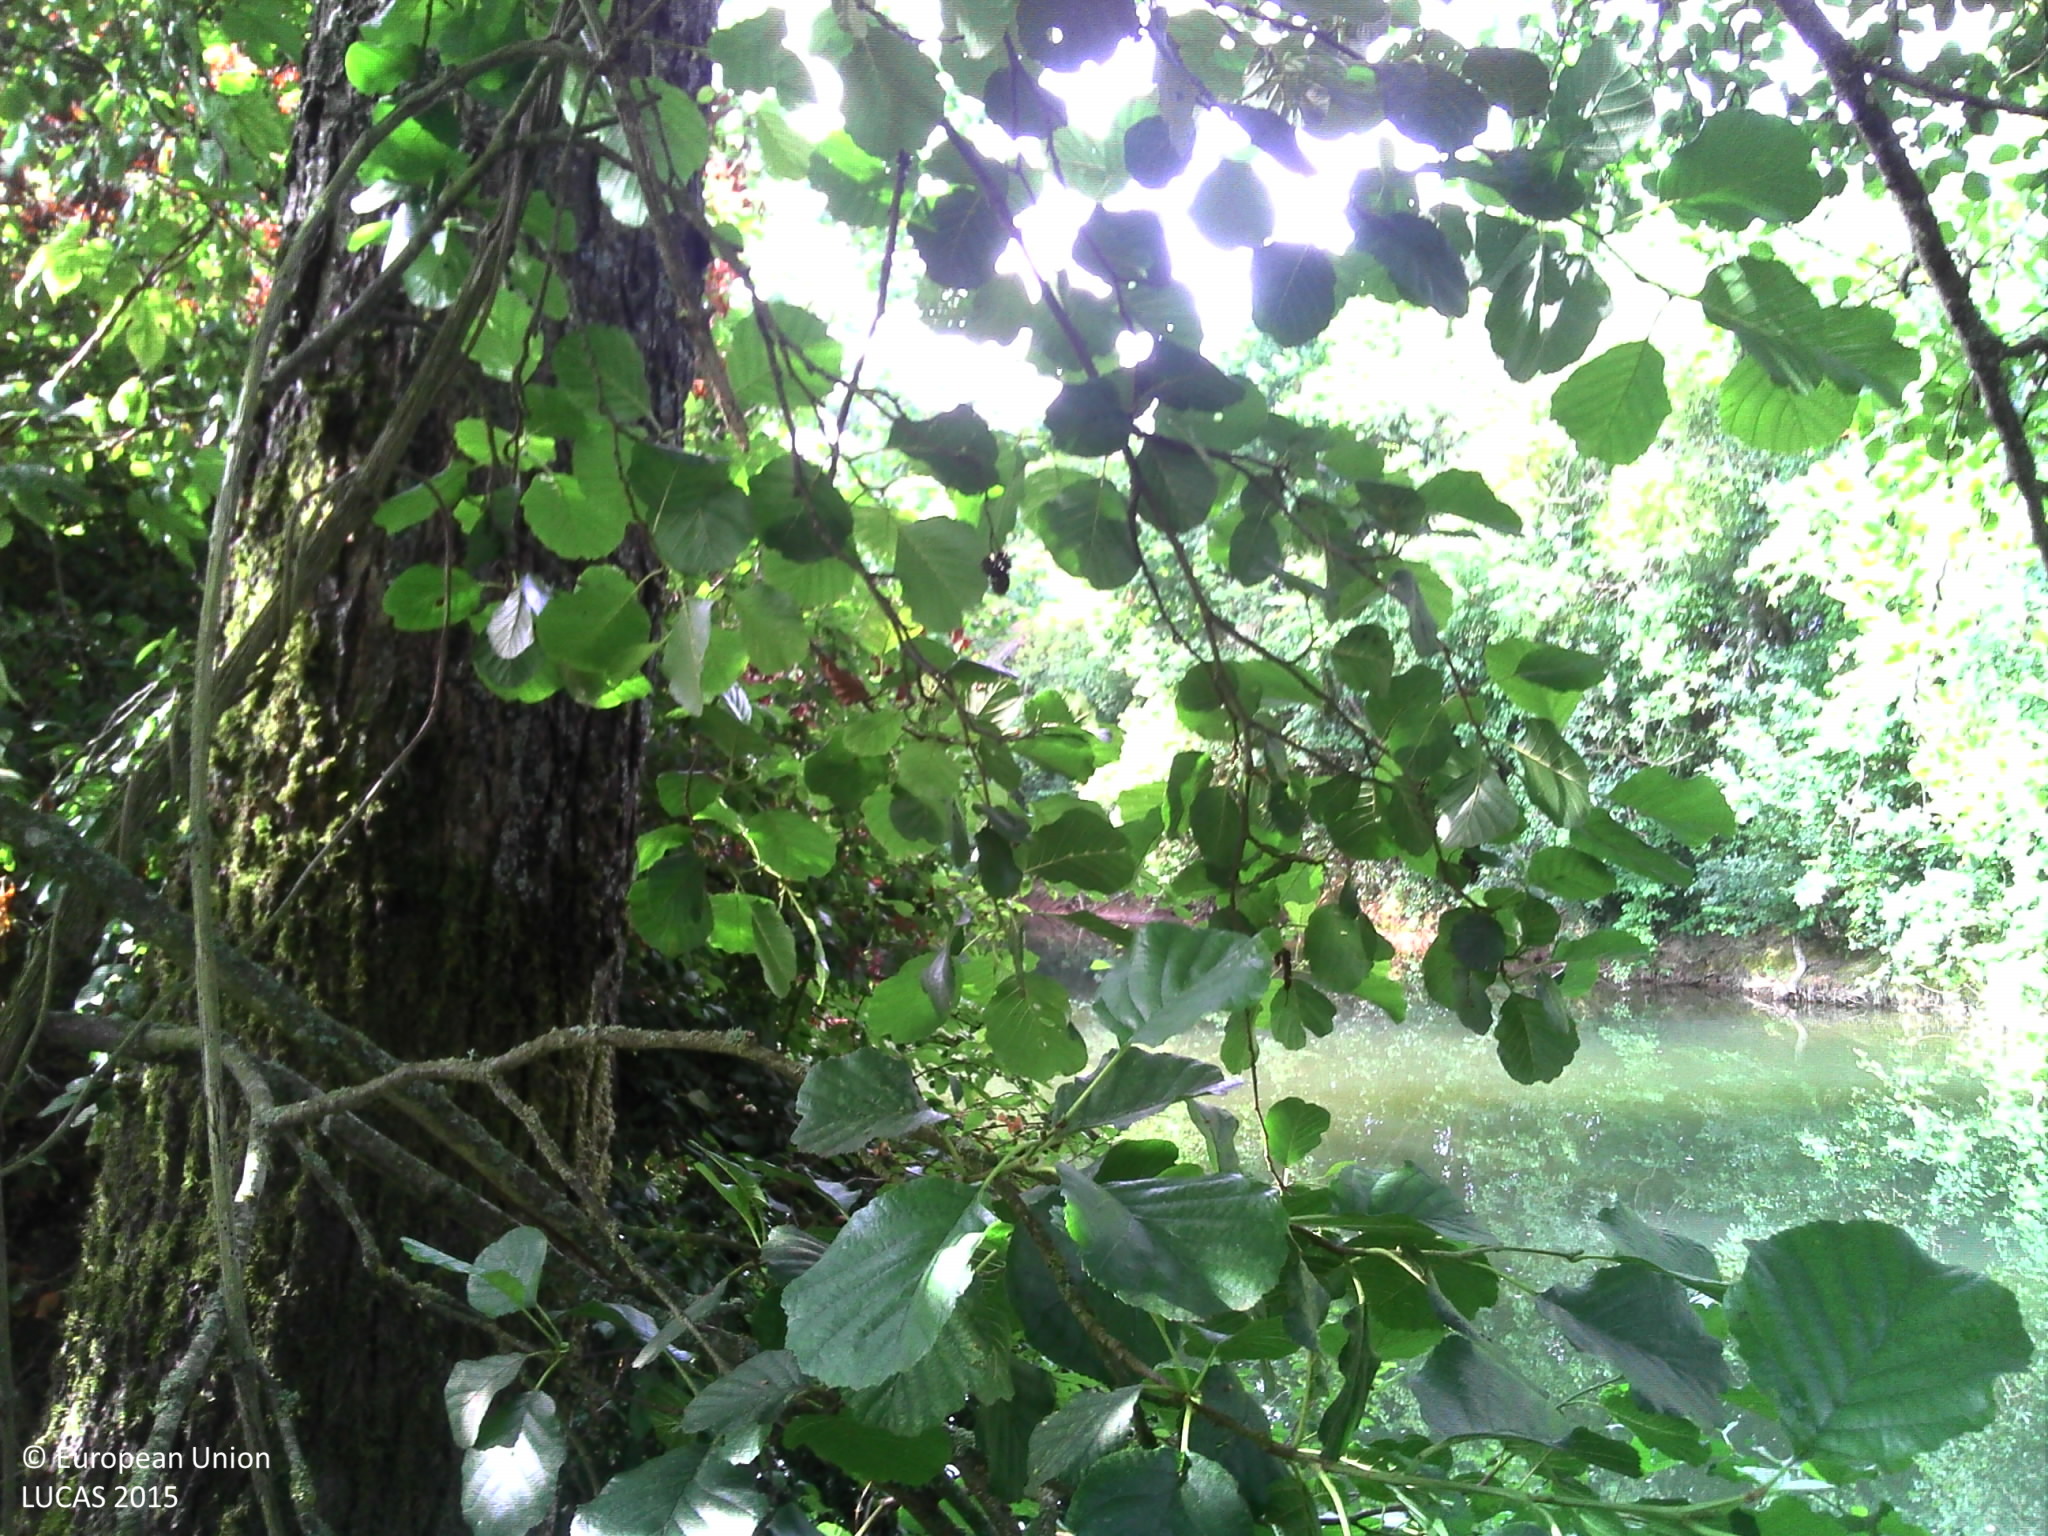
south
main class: Woodland
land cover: Broadleaved woodland
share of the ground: > 75 %
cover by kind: broadleaved forest trees 95 %, herbaceous plants 5 %
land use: Semi-natural and natural areas not in use
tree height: > 5 m
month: July
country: FR
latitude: 49.2116
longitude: 5.0423
